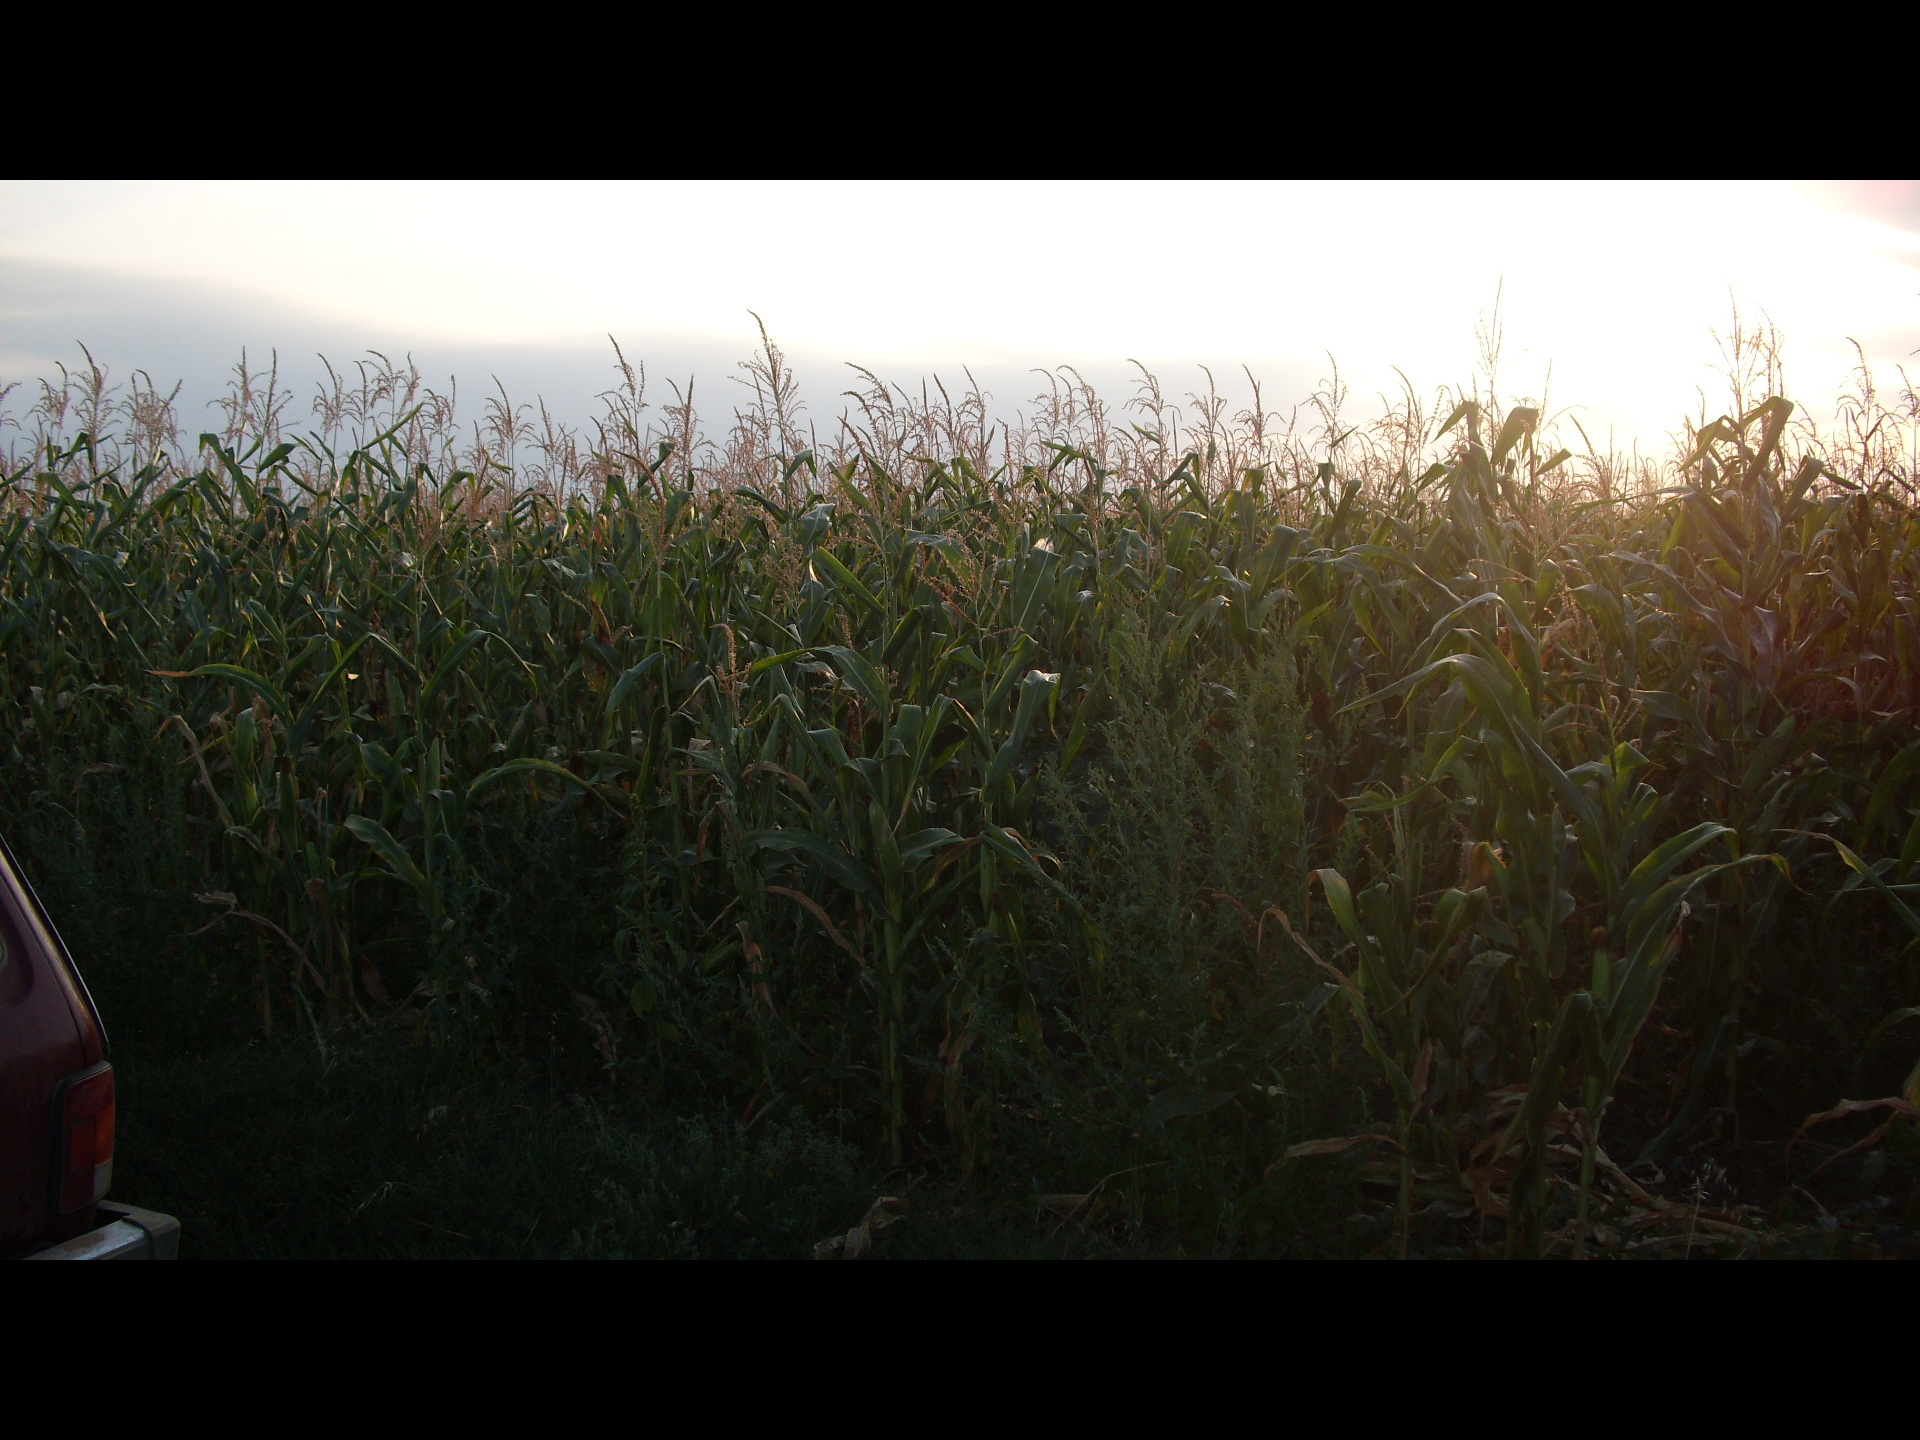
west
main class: Cropland
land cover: Sunflower
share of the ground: > 75 %
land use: Agriculture (excluding fallow land and kitchen gardens)
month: August
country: BG
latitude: 43.5951
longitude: 23.6109
